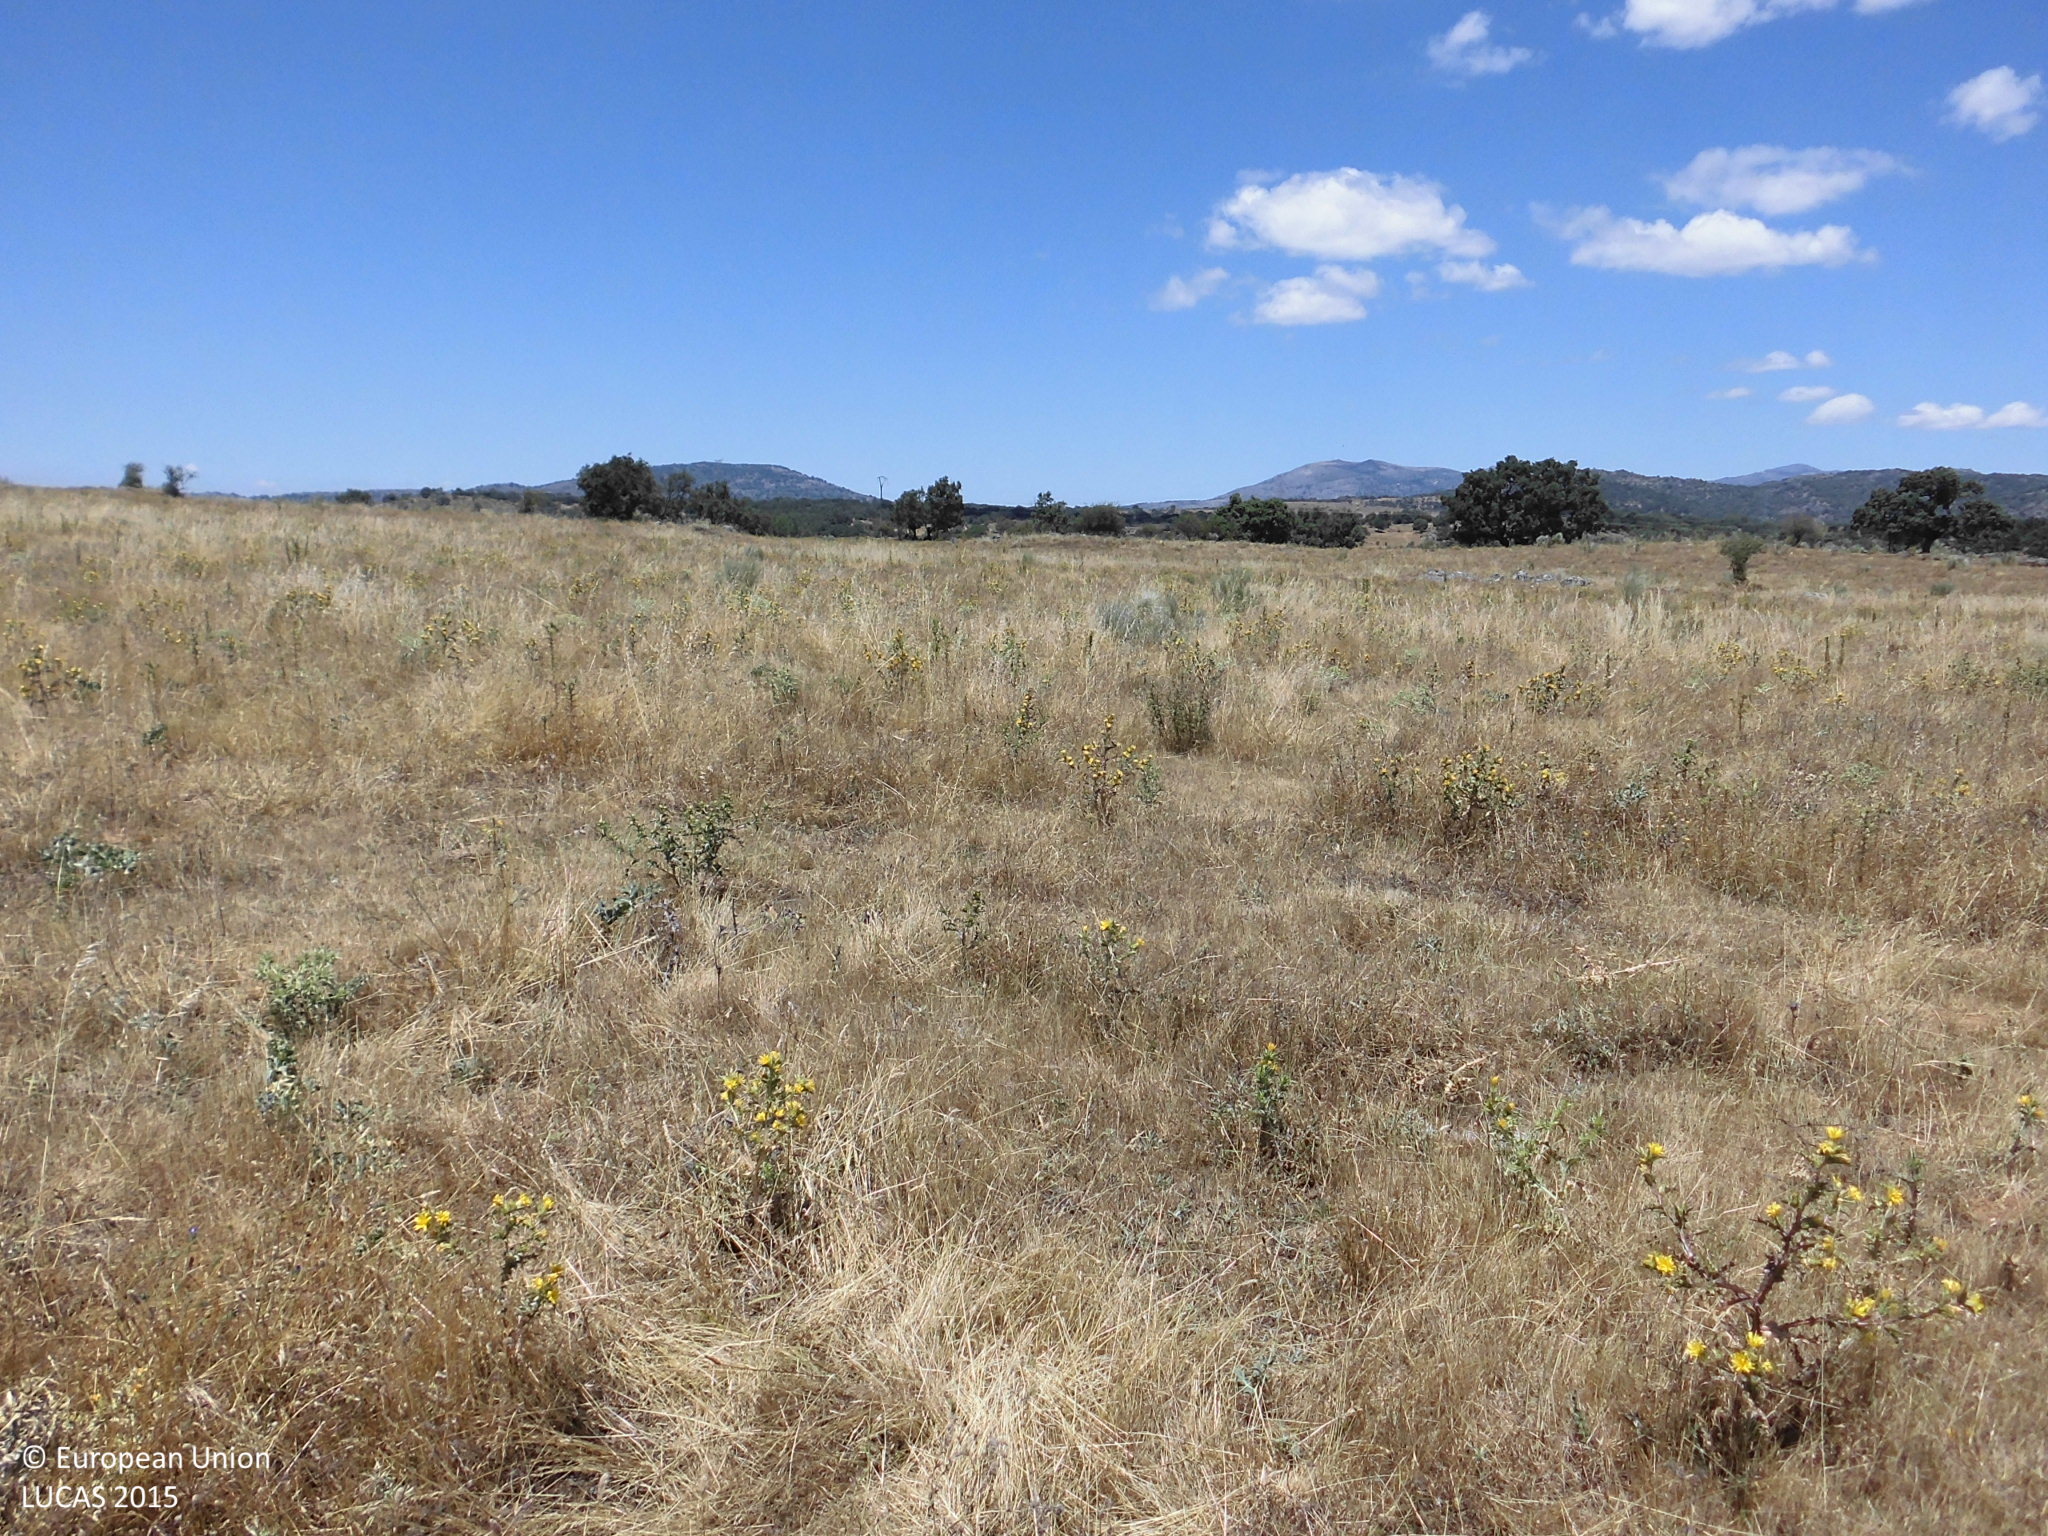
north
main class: Grassland
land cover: Grassland without tree/shrub cover
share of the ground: > 75 %
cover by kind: herbaceous plants 100 %
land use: Agriculture (excluding fallow land and kitchen gardens)
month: June
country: ES
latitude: 40.0096
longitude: -6.0136
